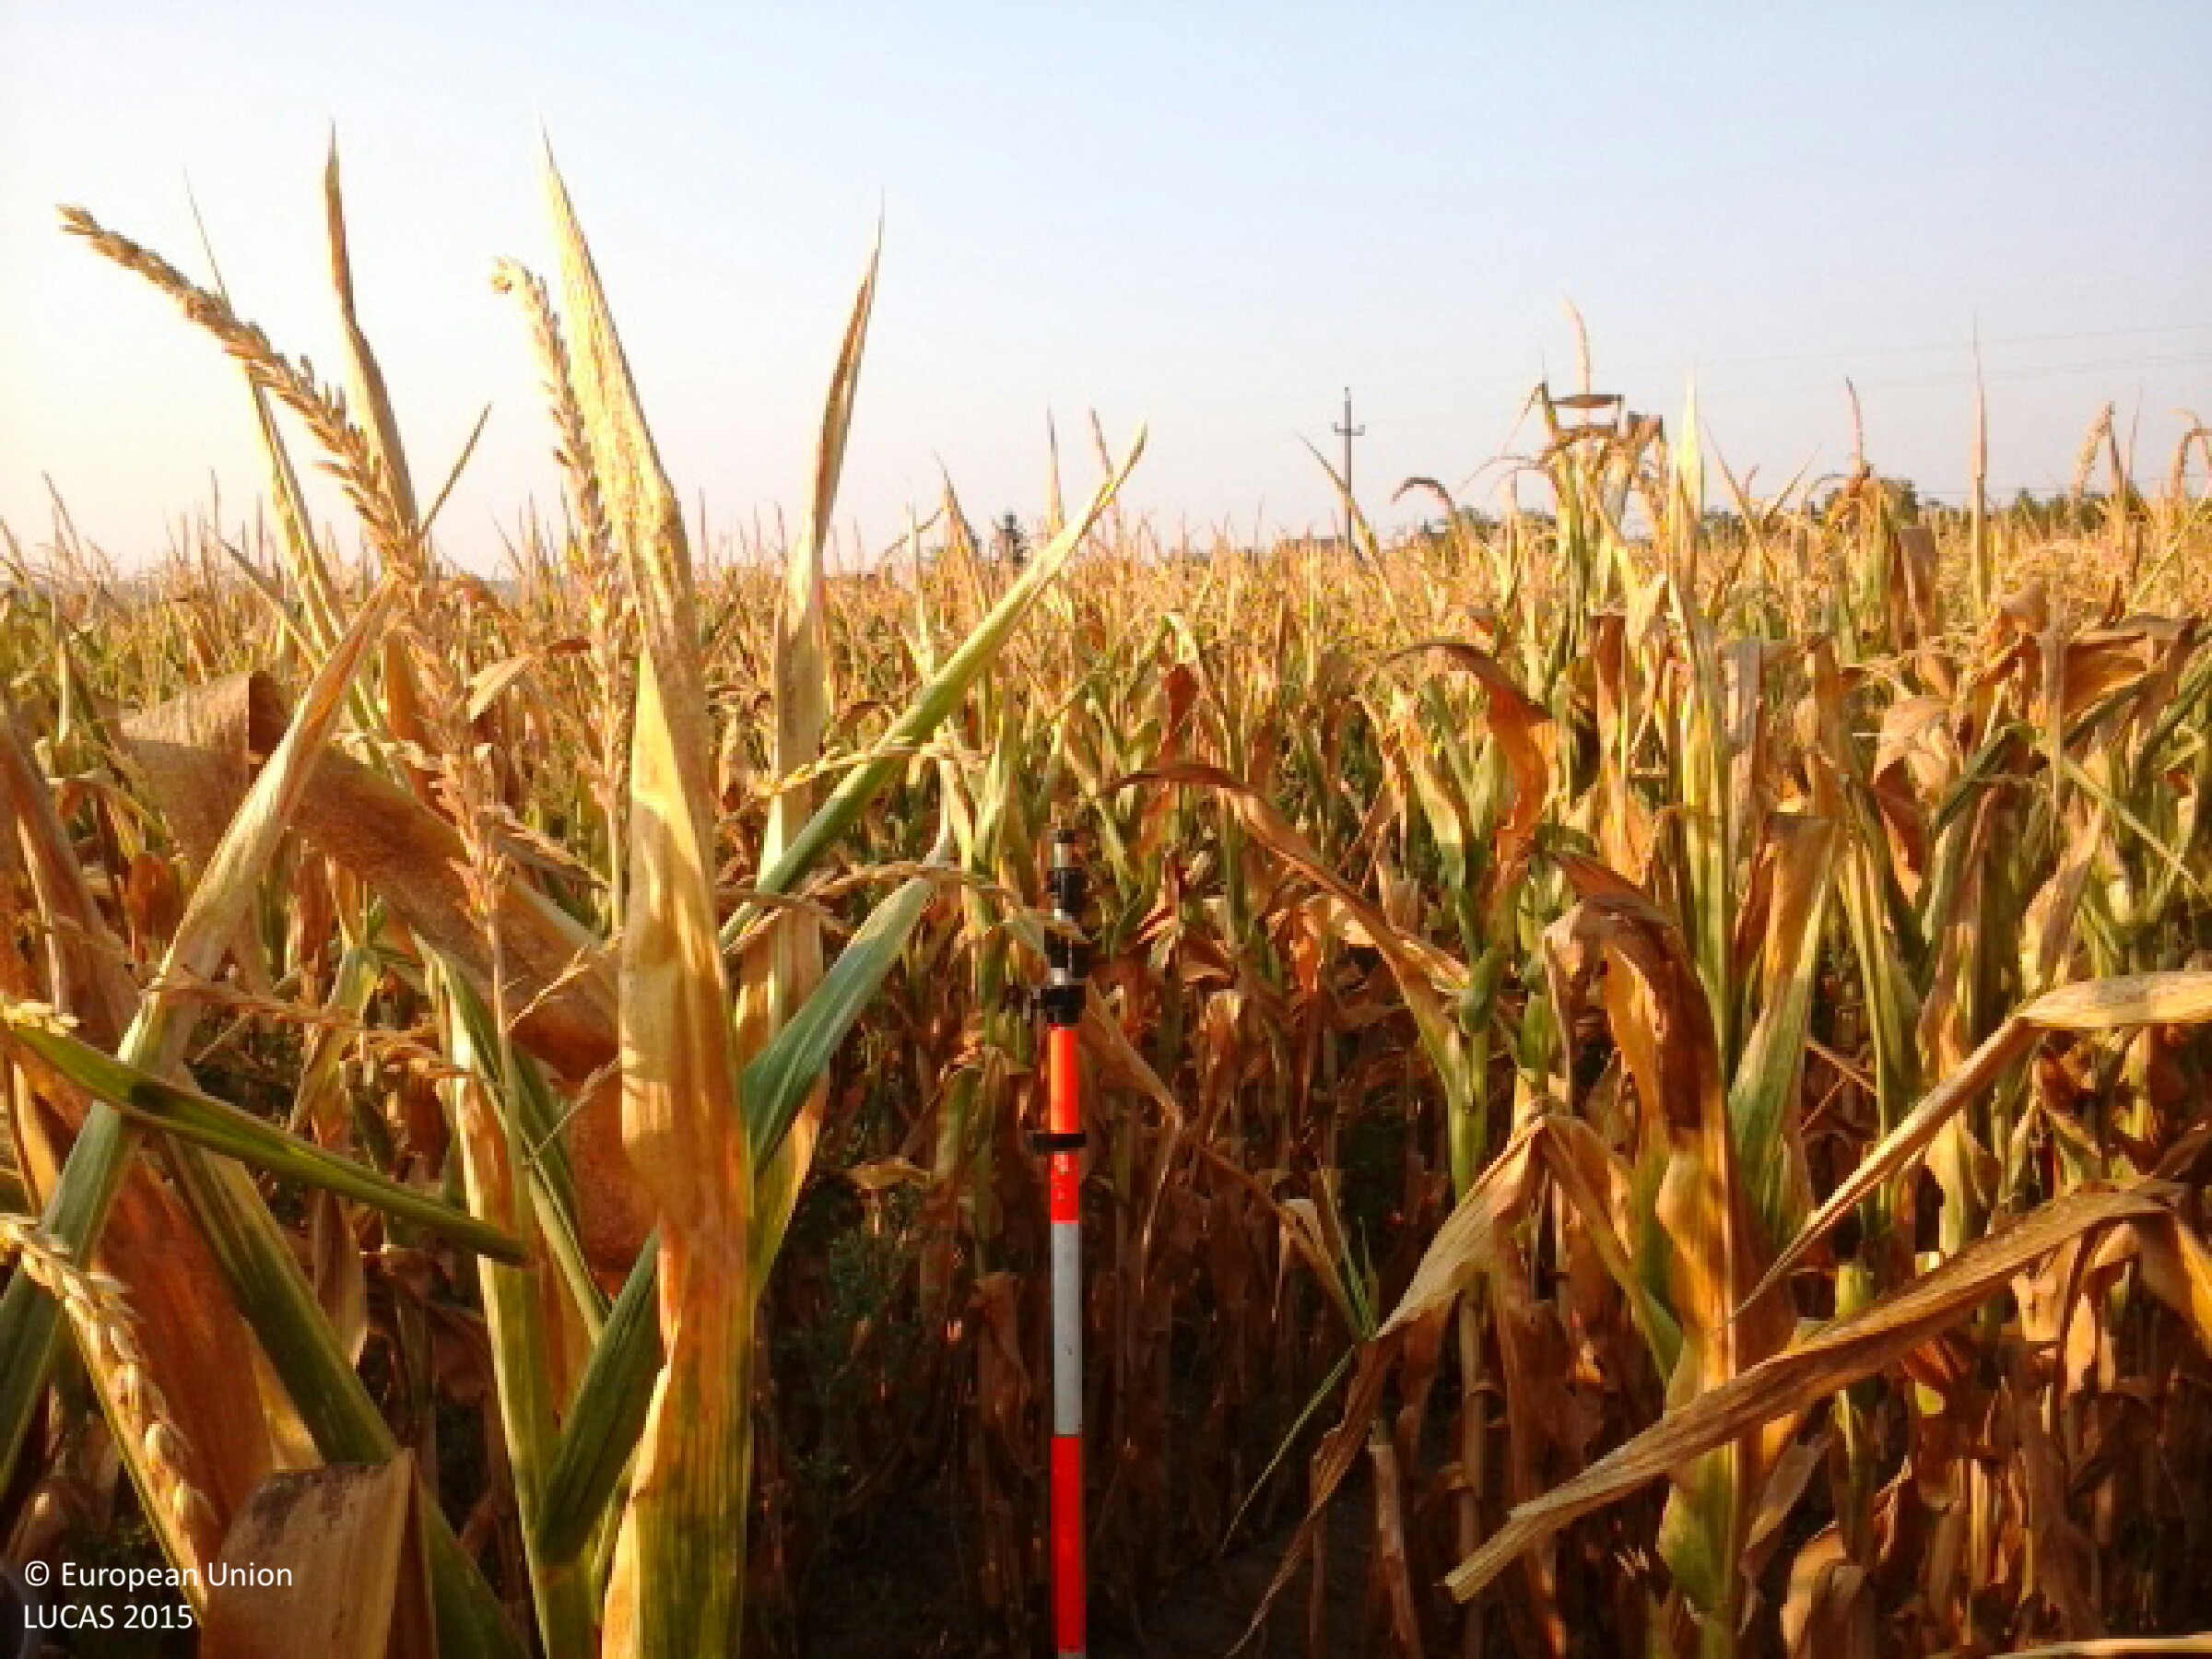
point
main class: Cropland
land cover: Maize
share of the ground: > 75 %
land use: Agriculture (excluding fallow land and kitchen gardens)
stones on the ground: < 10 %
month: August
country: HU
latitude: 47.2606
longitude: 18.5106
